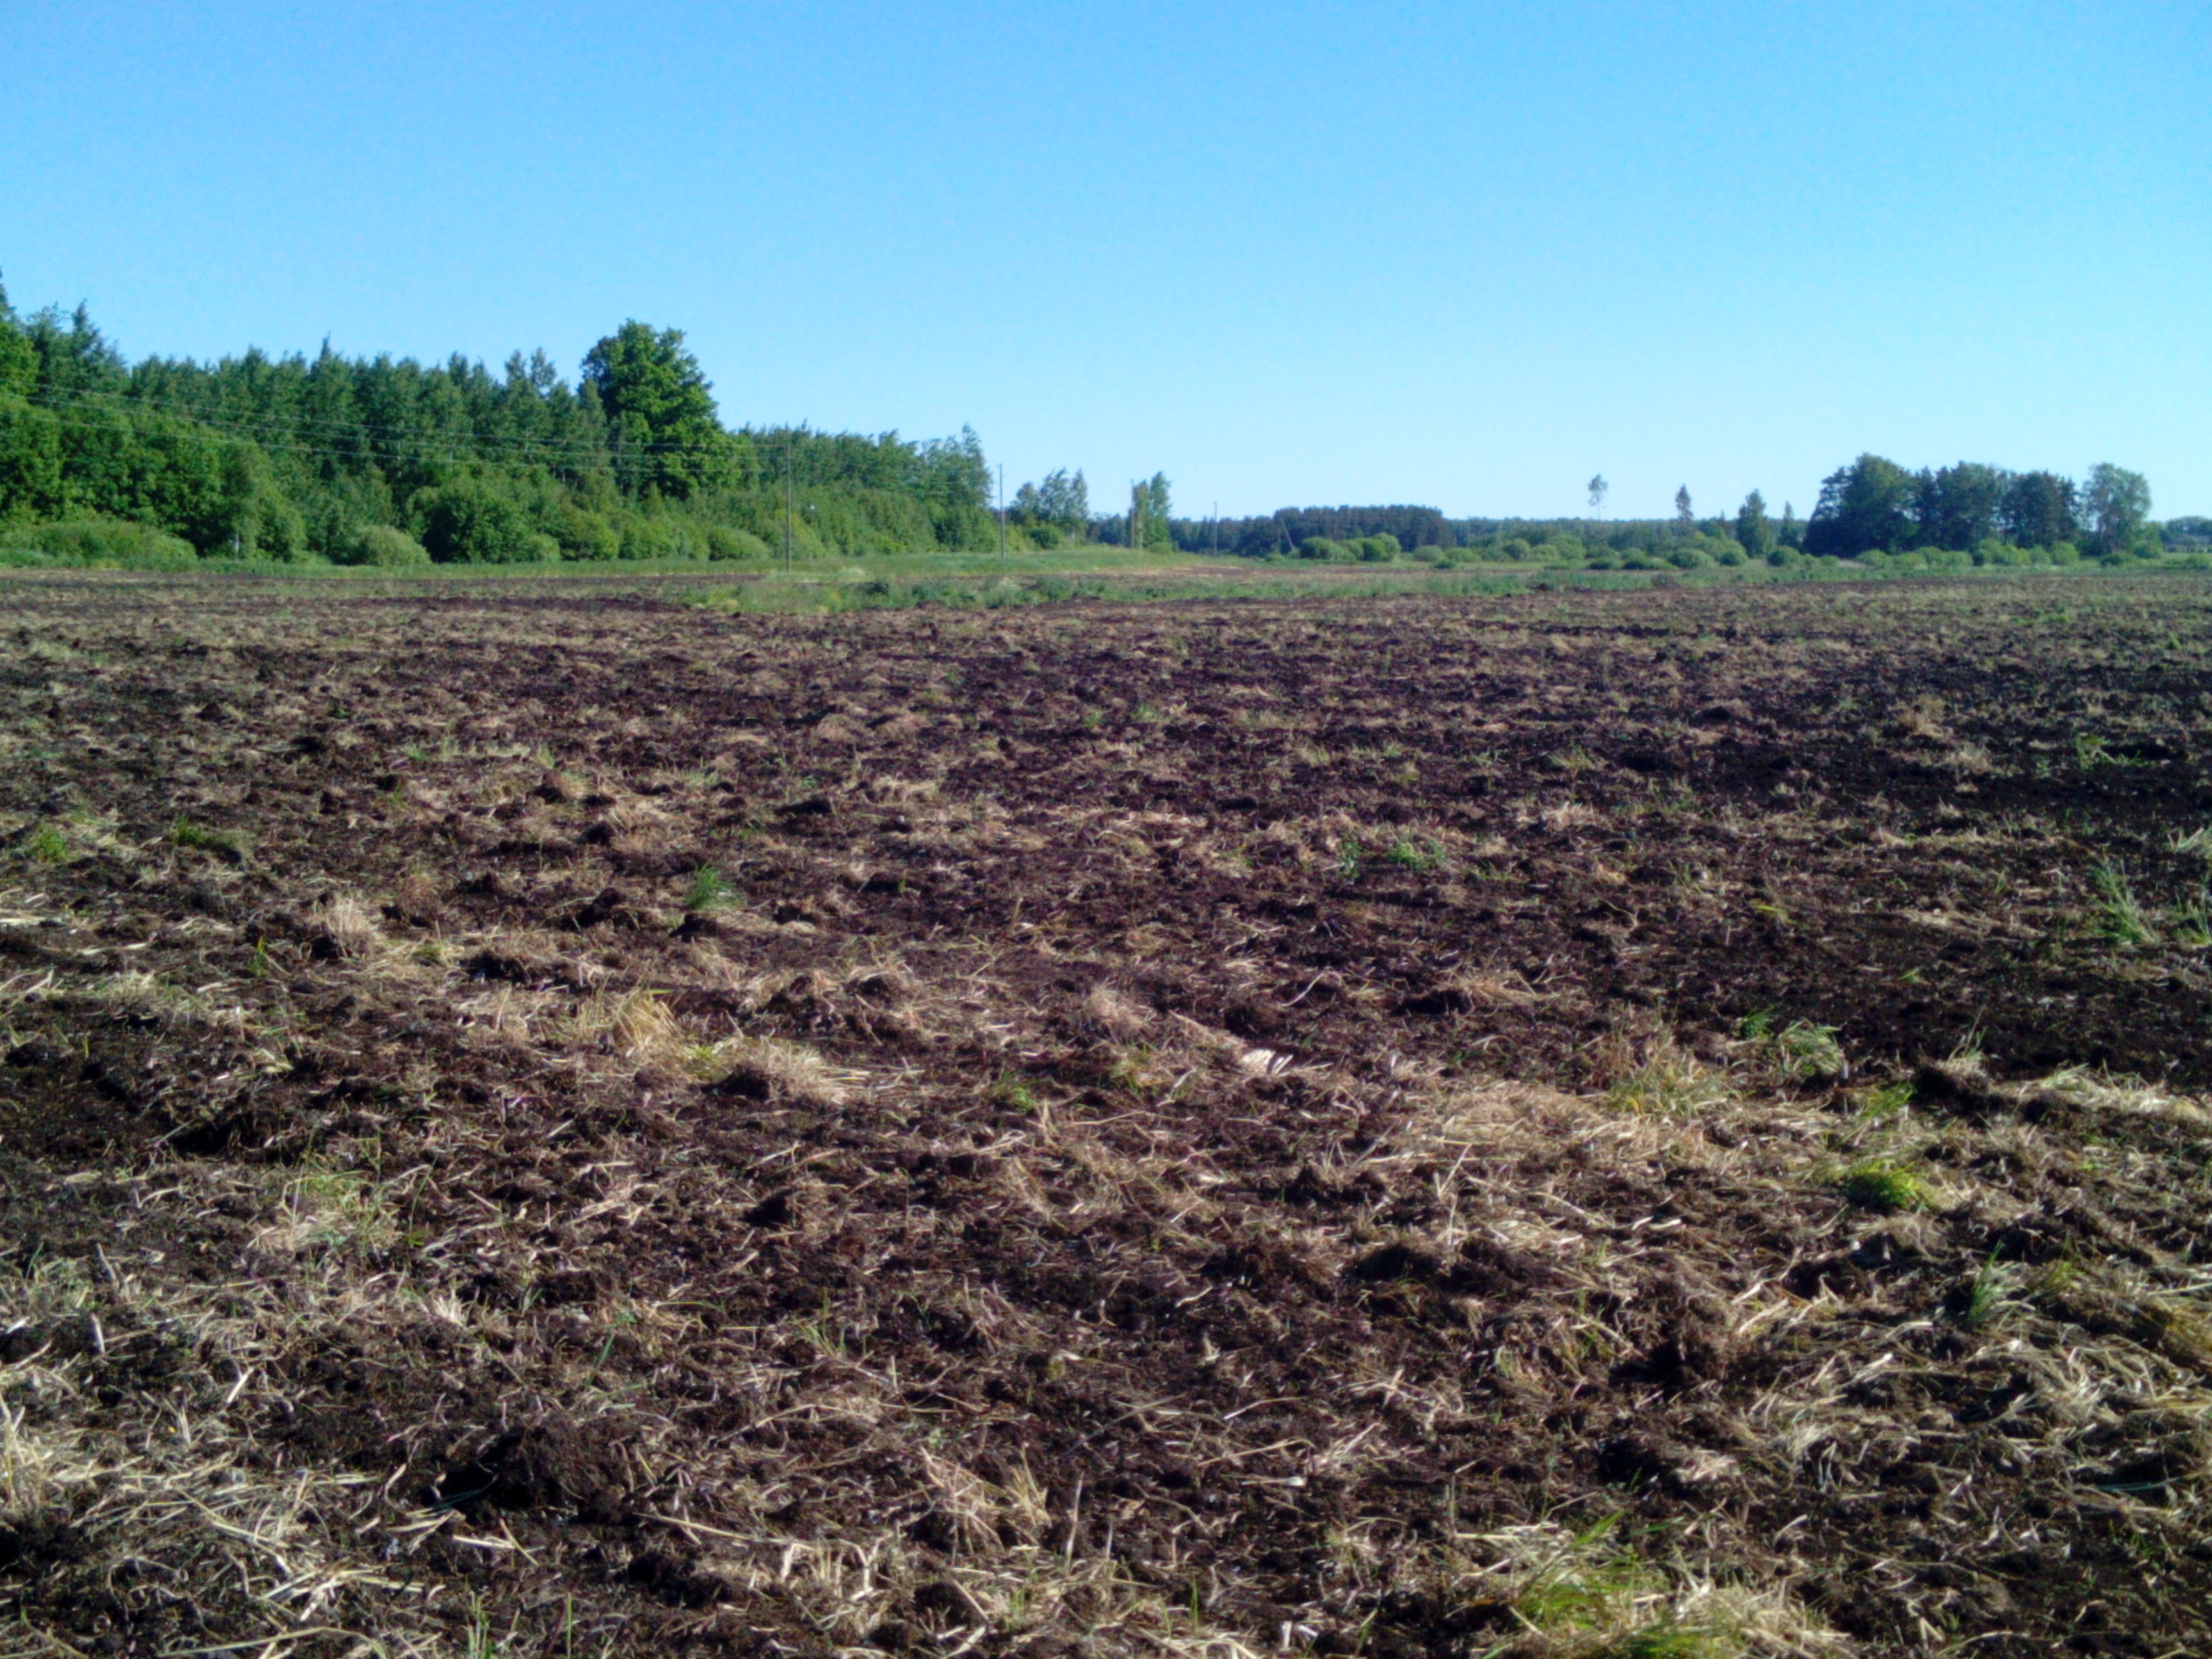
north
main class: Grassland
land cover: Spontaneously vegetated surfaces
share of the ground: 25 - 50 %
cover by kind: unconsolidated bare surface 75 %, herbaceous plants 25 %
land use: Agriculture (excluding fallow land and kitchen gardens)
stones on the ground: < 10 %
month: June
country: LV
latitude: 56.7772
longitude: 21.7123
